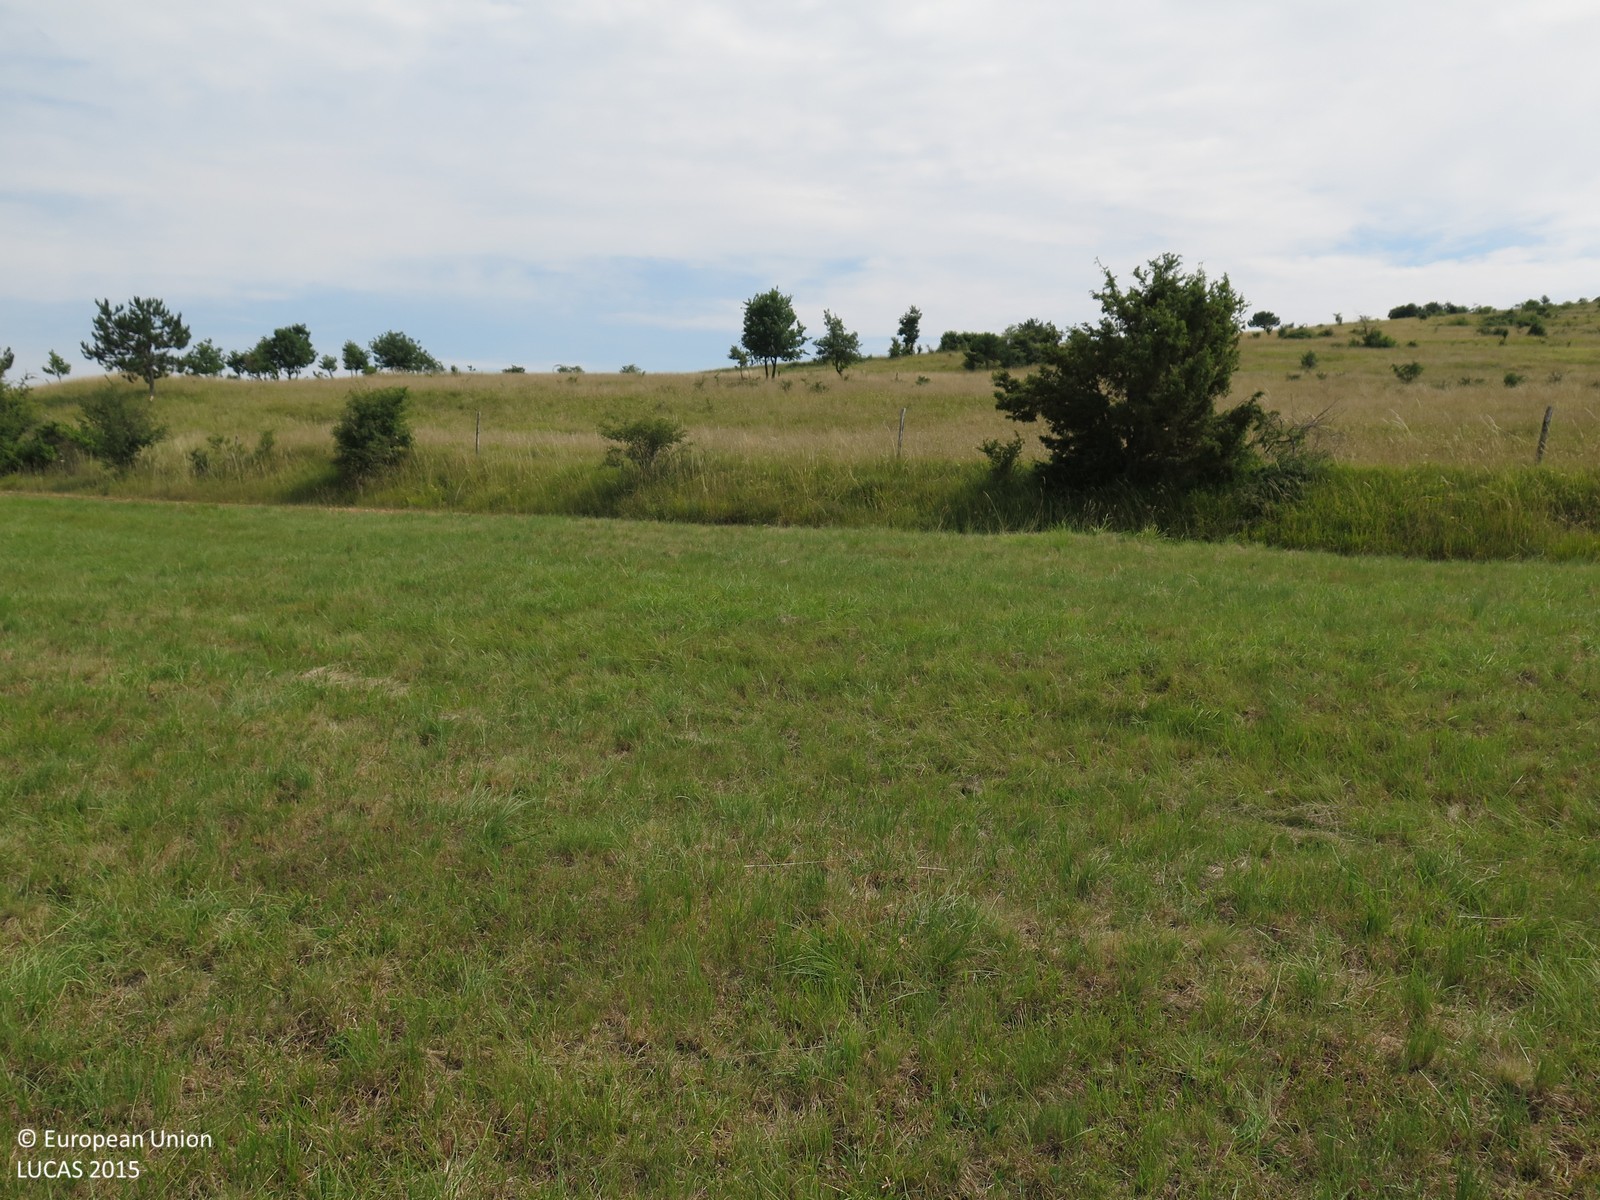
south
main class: Grassland
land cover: Grassland without tree/shrub cover
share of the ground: > 75 %
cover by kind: herbaceous plants 100 %
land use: Agriculture (excluding fallow land and kitchen gardens)
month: June
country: HR
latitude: 45.2734
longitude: 13.8061
